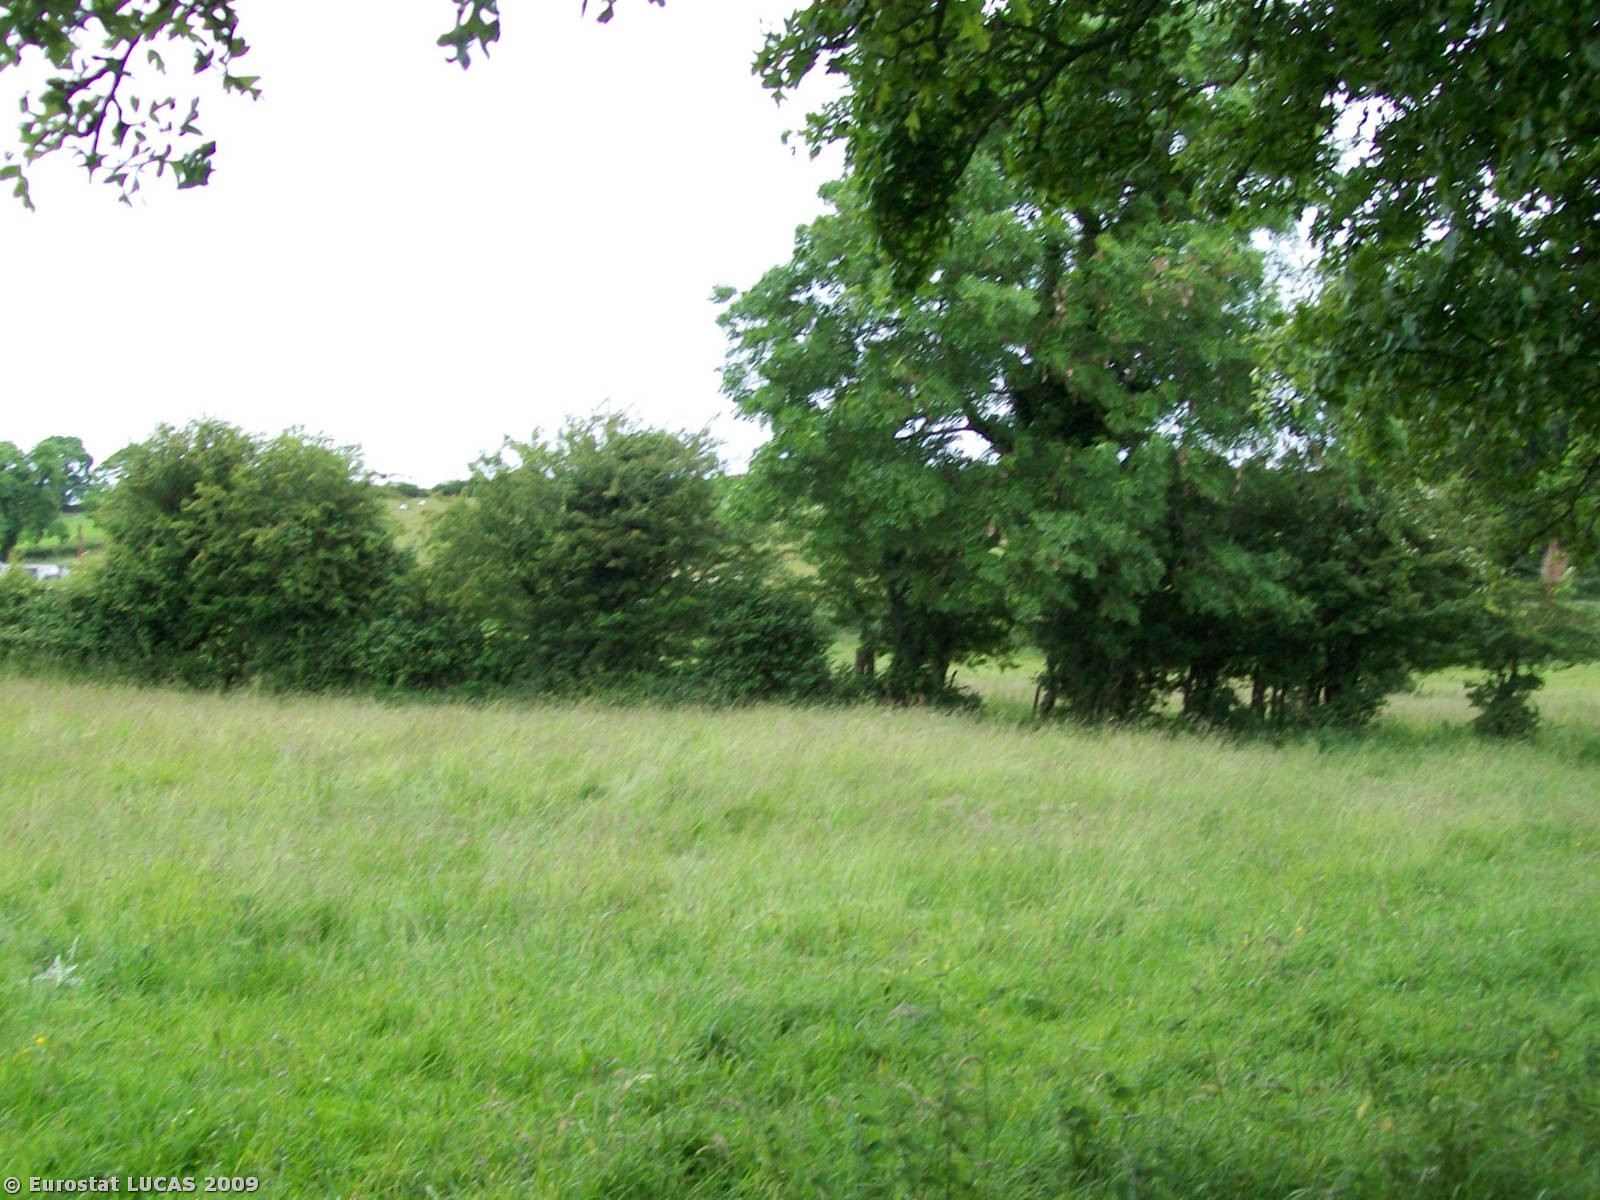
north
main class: Grassland
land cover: Grassland without tree/shrub cover
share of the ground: > 75 %
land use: Agriculture (excluding fallow land and kitchen gardens)
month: June
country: IE
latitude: 53.1612
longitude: -8.4847
